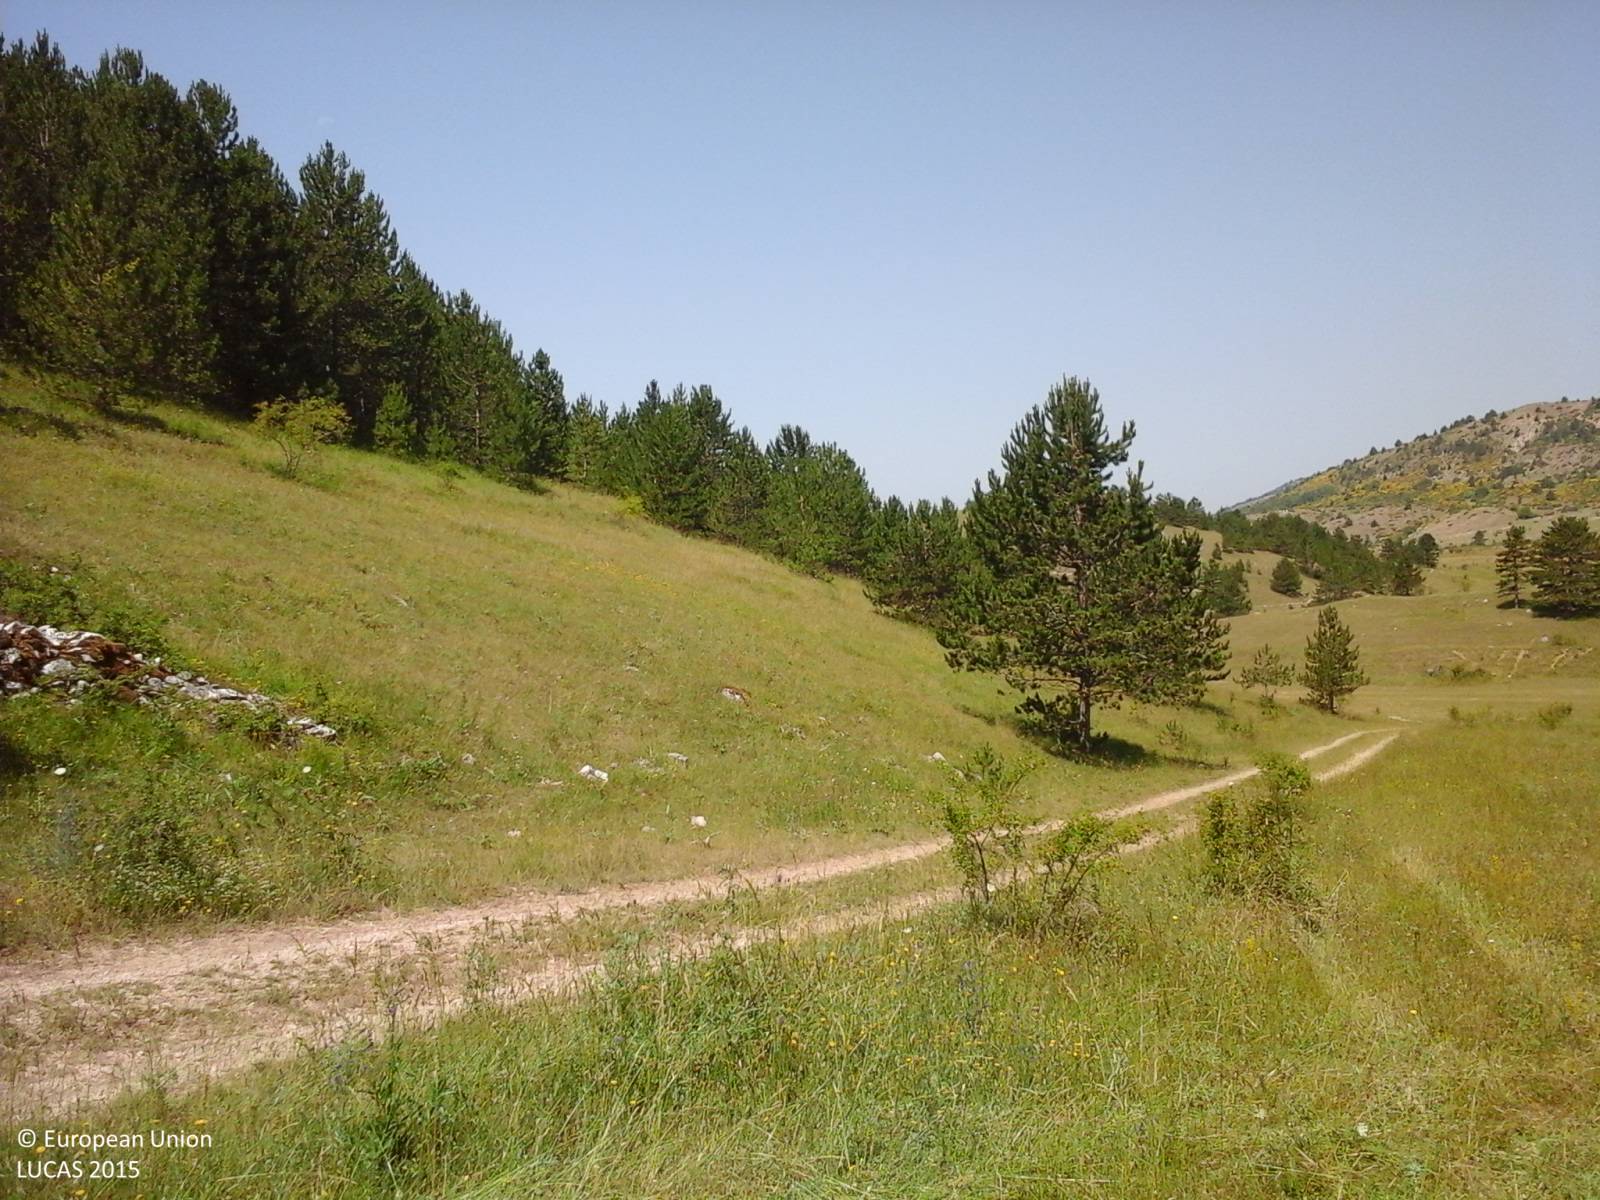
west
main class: Grassland
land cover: Grassland without tree/shrub cover
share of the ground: > 75 %
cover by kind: herbaceous plants 100 %
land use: Agriculture (excluding fallow land and kitchen gardens)
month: July
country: IT
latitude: 42.4161
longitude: 13.4040
